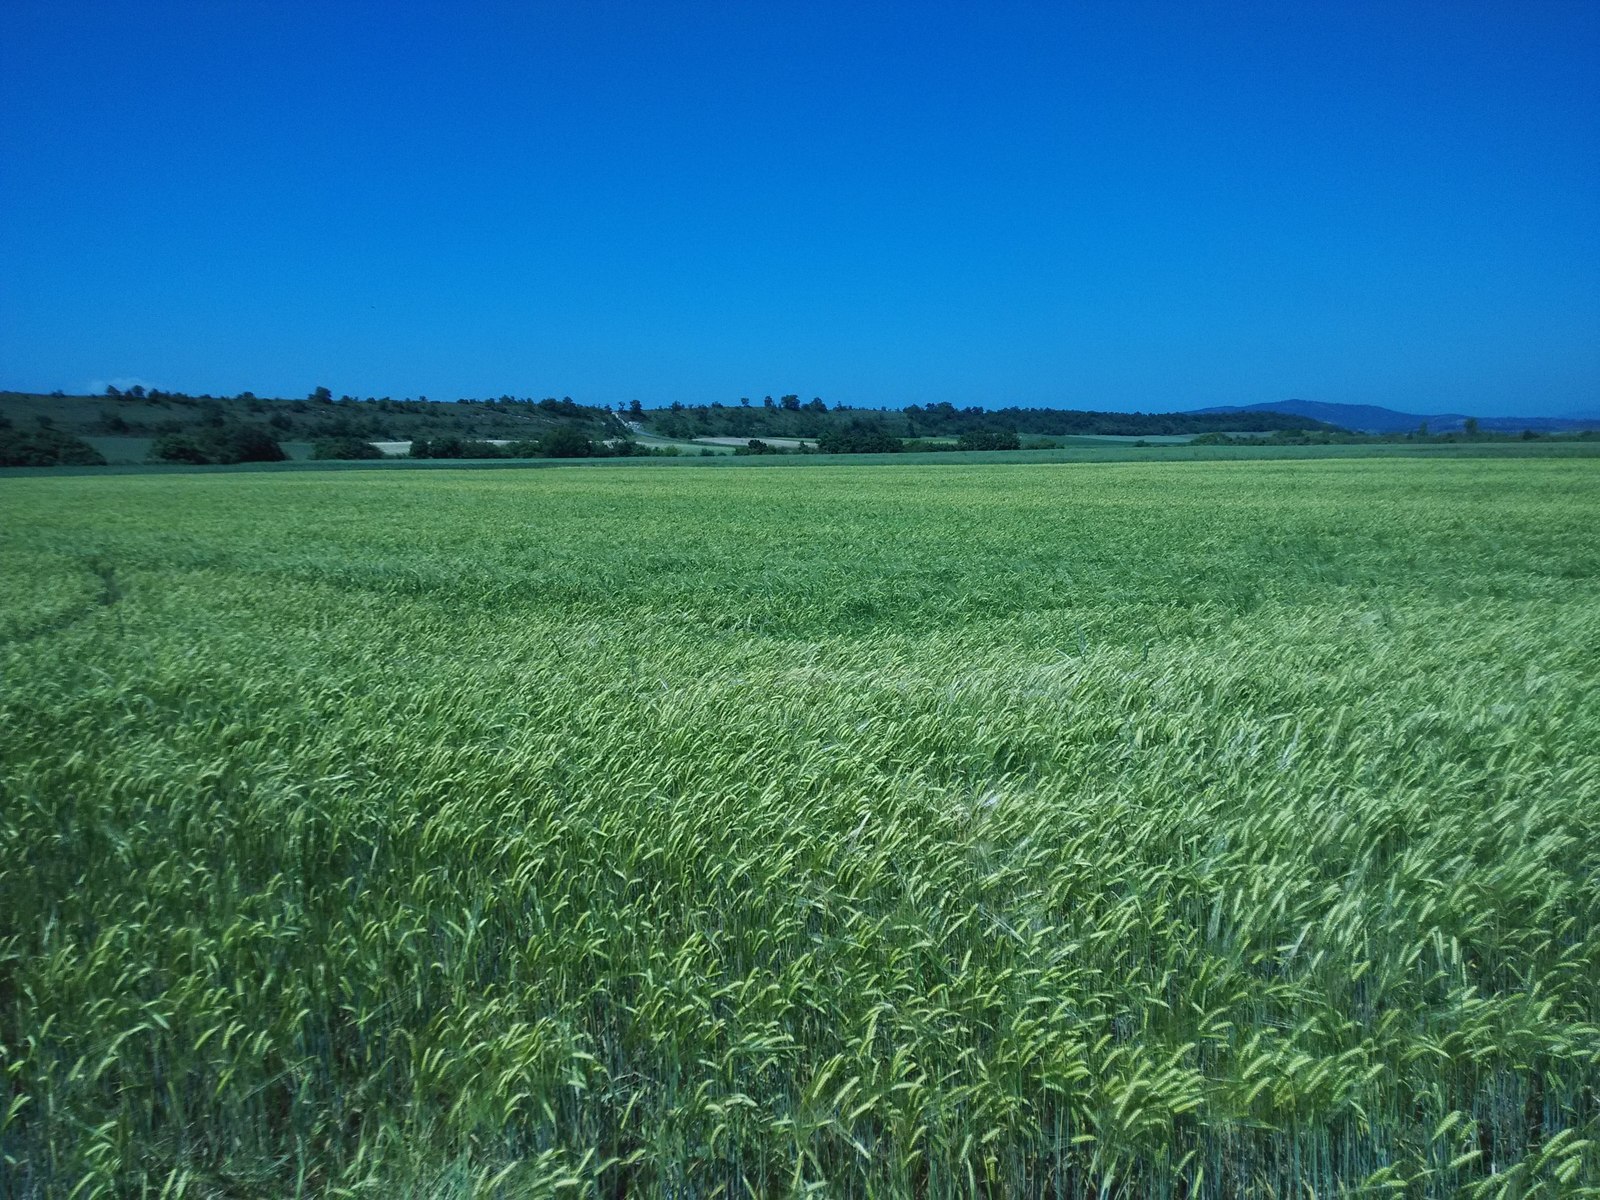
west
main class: Cropland
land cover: Barley
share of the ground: > 75 %
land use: Agriculture (excluding fallow land and kitchen gardens)
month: June
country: ES
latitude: 42.8801
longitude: -2.3518
